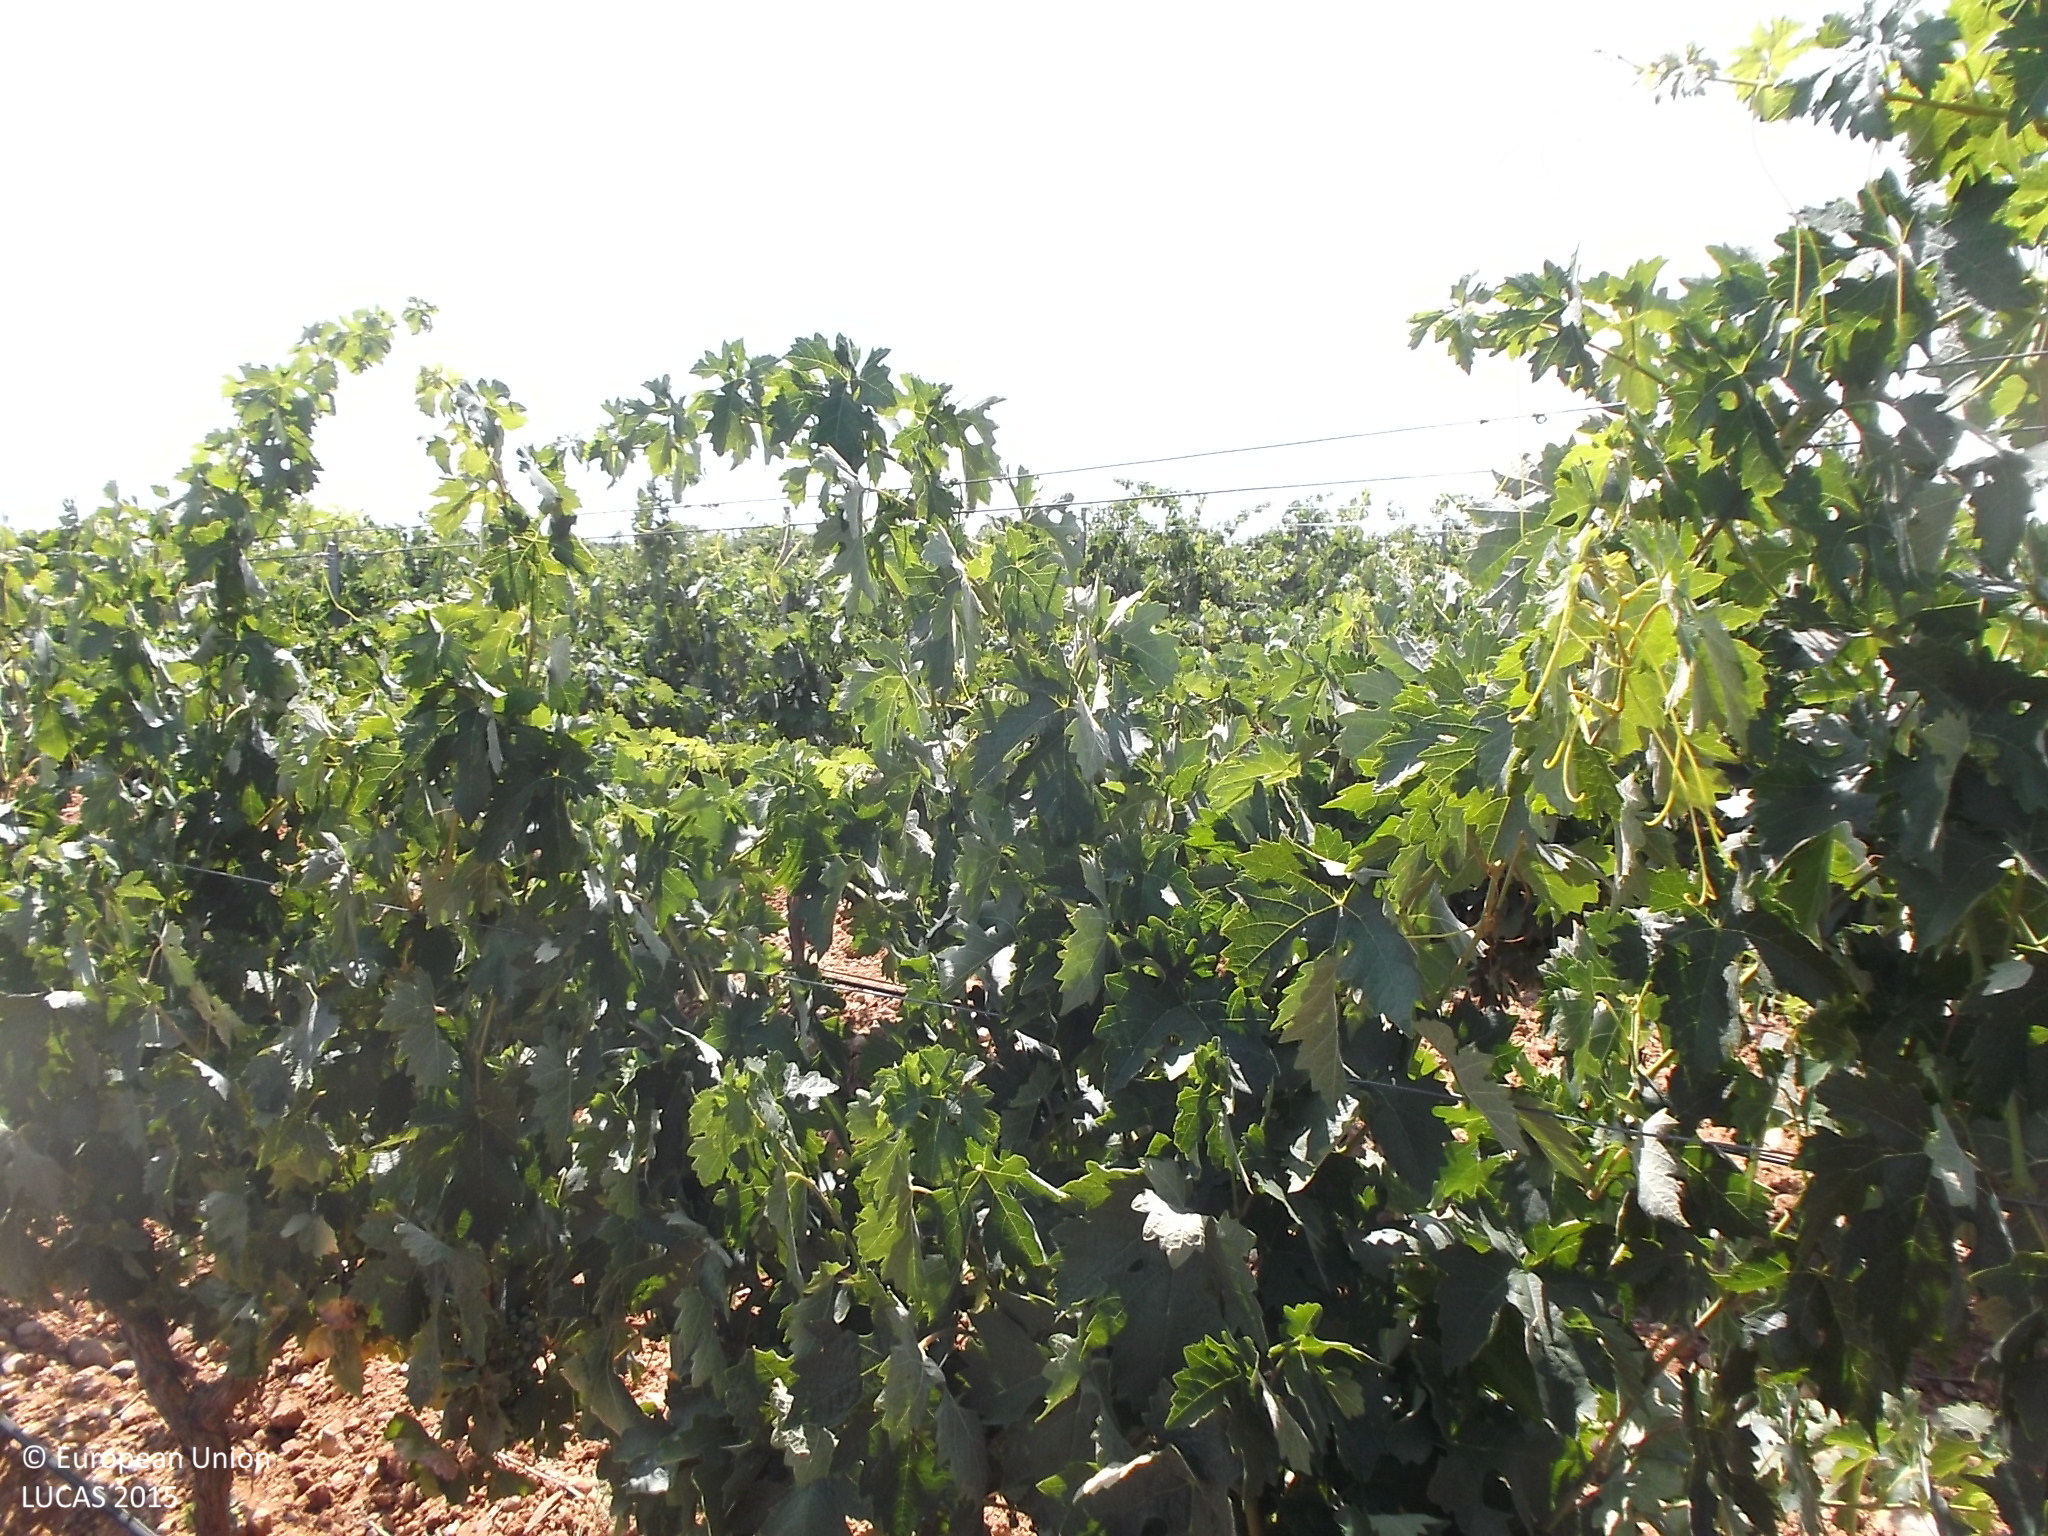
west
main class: Cropland
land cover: Vineyards
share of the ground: 10 - 25 %
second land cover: Other bare soil
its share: > 75 %
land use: Agriculture (excluding fallow land and kitchen gardens)
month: July
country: ES
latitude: 41.4837
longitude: -5.2995
